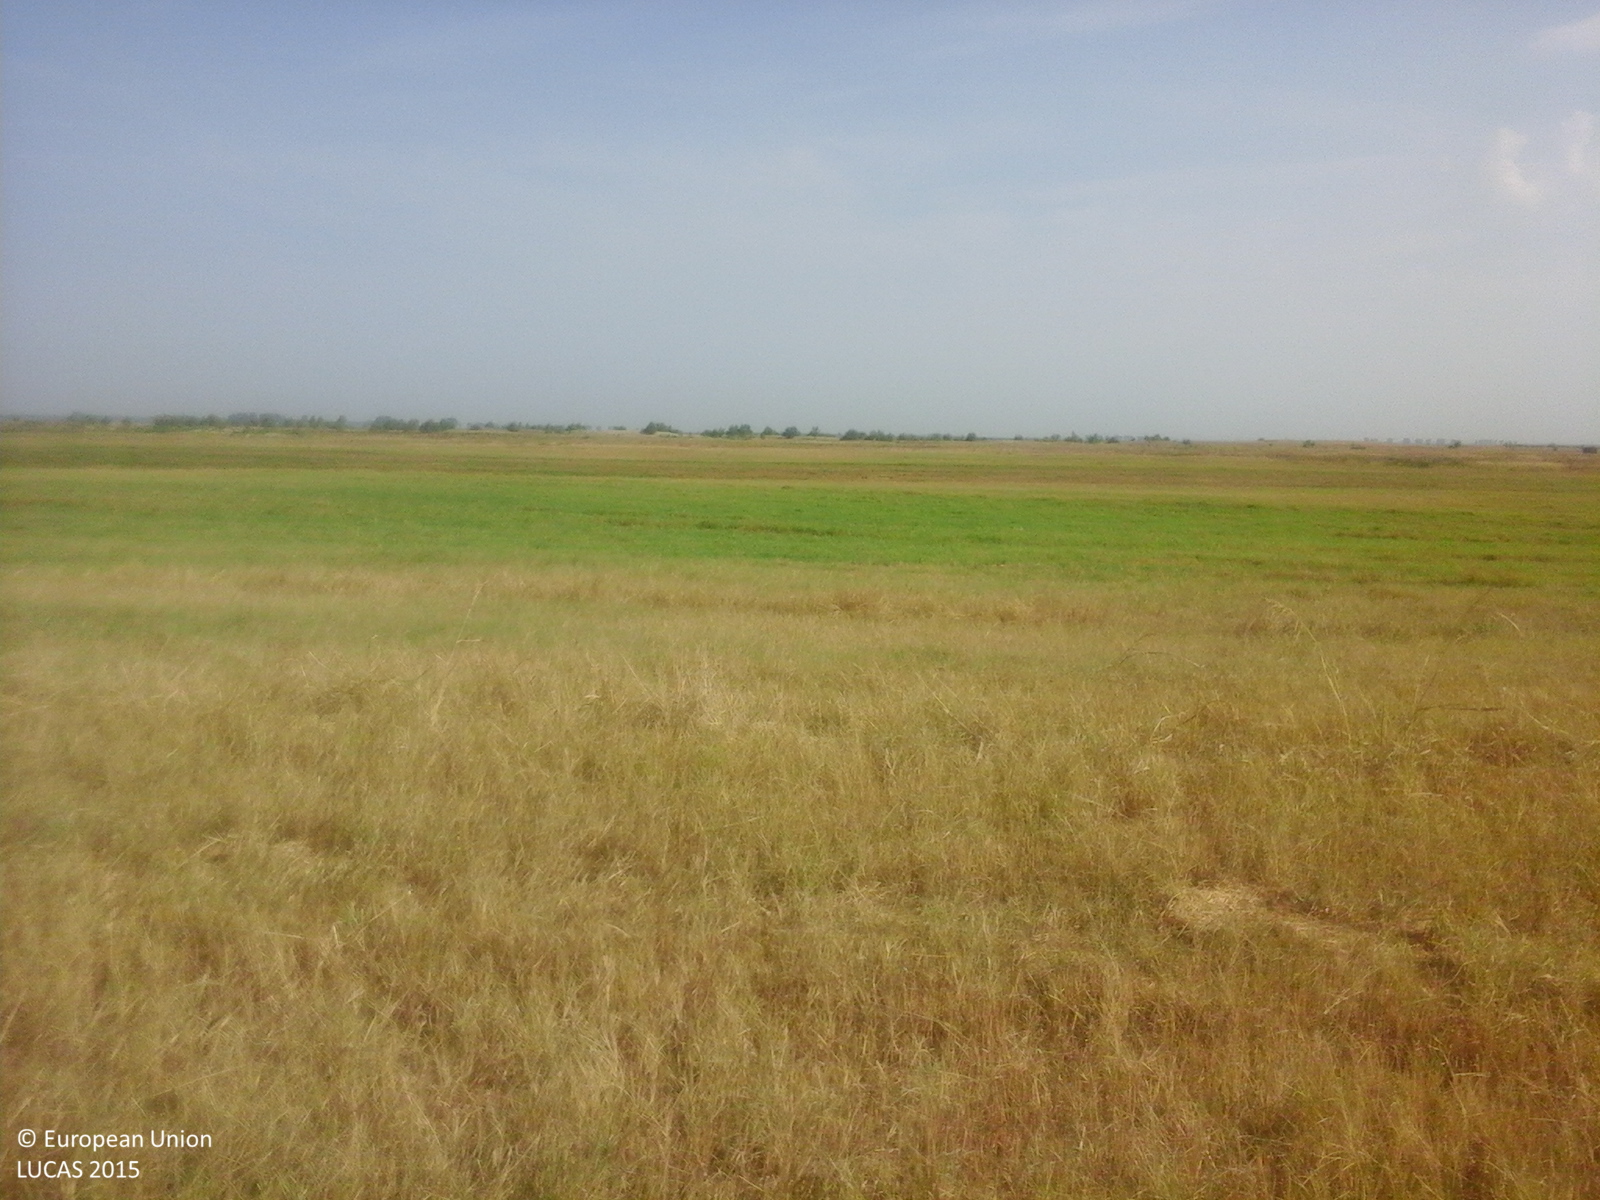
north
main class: Cropland
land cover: Sunflower
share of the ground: > 75 %
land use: Agriculture (excluding fallow land and kitchen gardens)
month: August
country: RO
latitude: 43.8416
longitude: 23.5434
